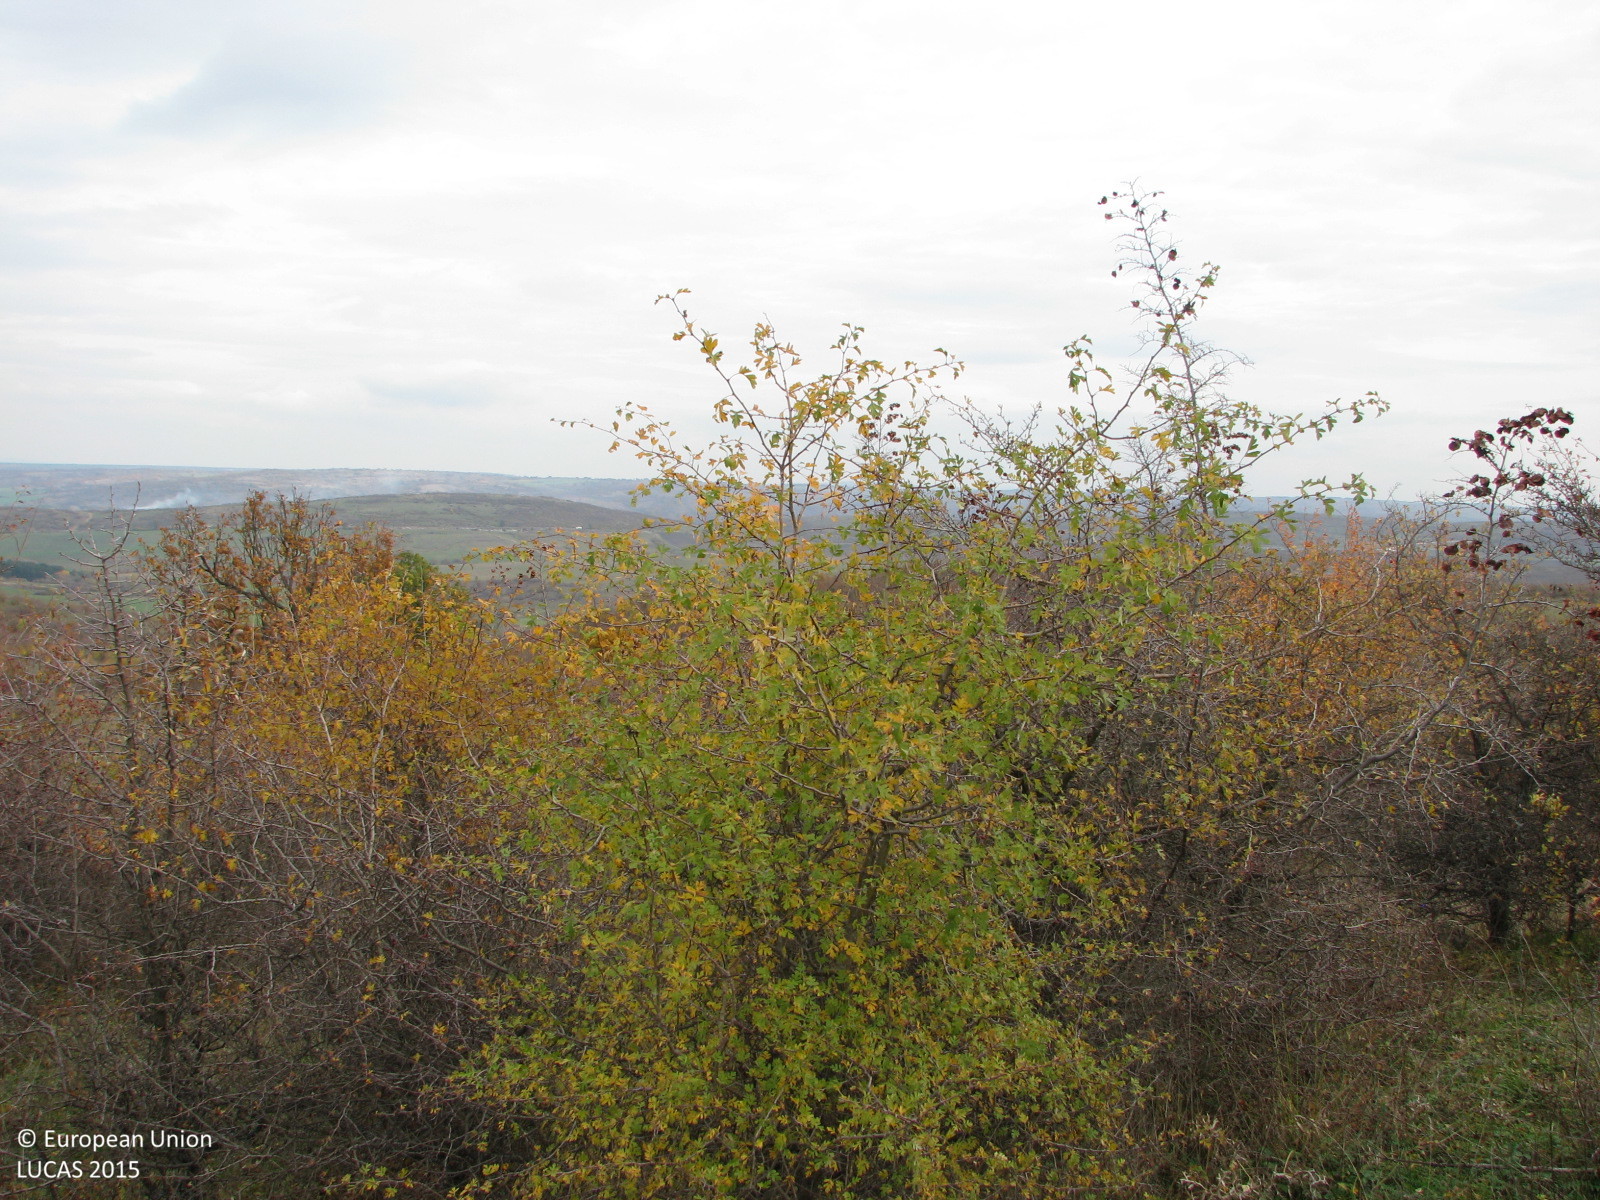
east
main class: Shrubland
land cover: Shrubland without tree cover
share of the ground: 50 - 75 %
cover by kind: shrubs 55 %, herbaceous plants 45 %
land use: Agriculture (excluding fallow land and kitchen gardens)
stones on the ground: < 10 %
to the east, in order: Shrubland without tree cover; Grassland with sparse tree/shrub cover; Broadleaved woodland; Rivers and streams; Broadleaved woodland; Grassland with sparse tree/shrub cover; Broadleaved woodland; Rivers and streams; Broadleaved woodland; Grassland with sparse tree/shrub cover
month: November
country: BG
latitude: 41.9984
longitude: 26.4426
